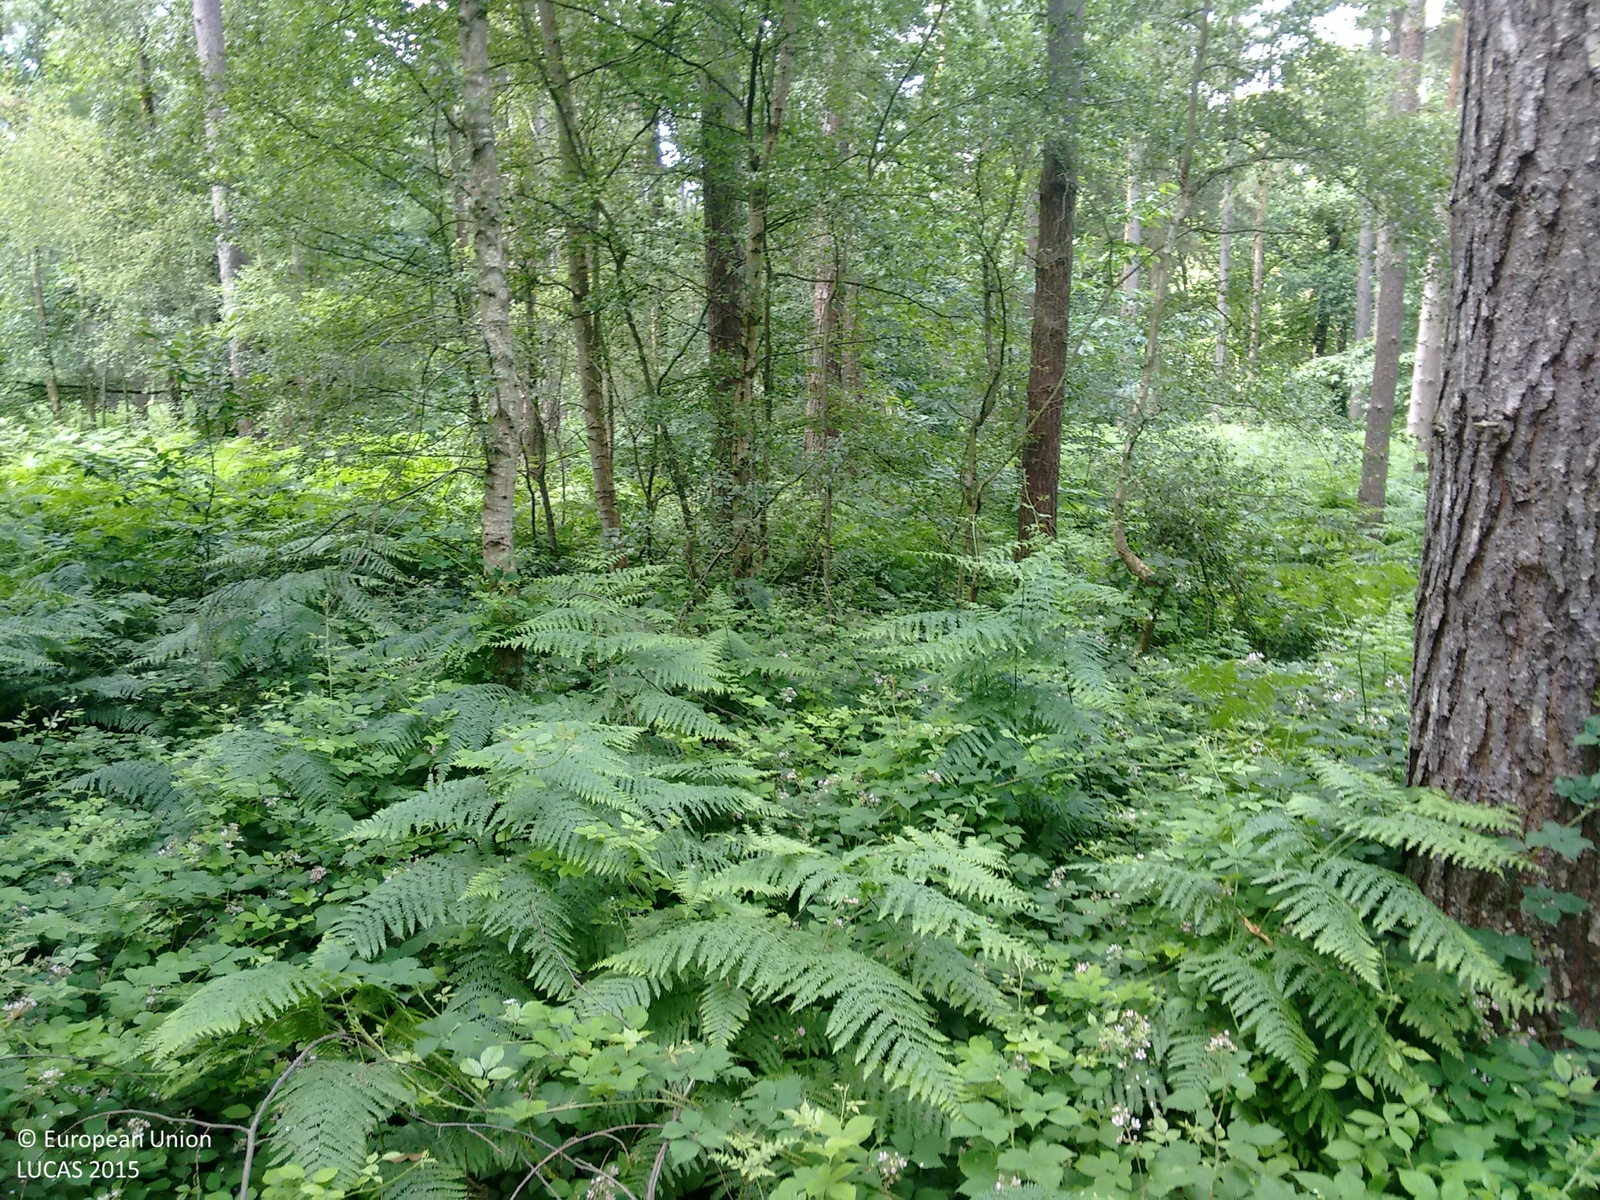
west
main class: Woodland
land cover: Pine dominated coniferous woodland
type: exotic forest
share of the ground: > 75 %
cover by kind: coniferous forest trees 90 %, broadleaved forest trees 10 %
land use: Forestry
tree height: > 5 m
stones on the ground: < 10 %
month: July
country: GB
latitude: 53.2947
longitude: -1.0413
